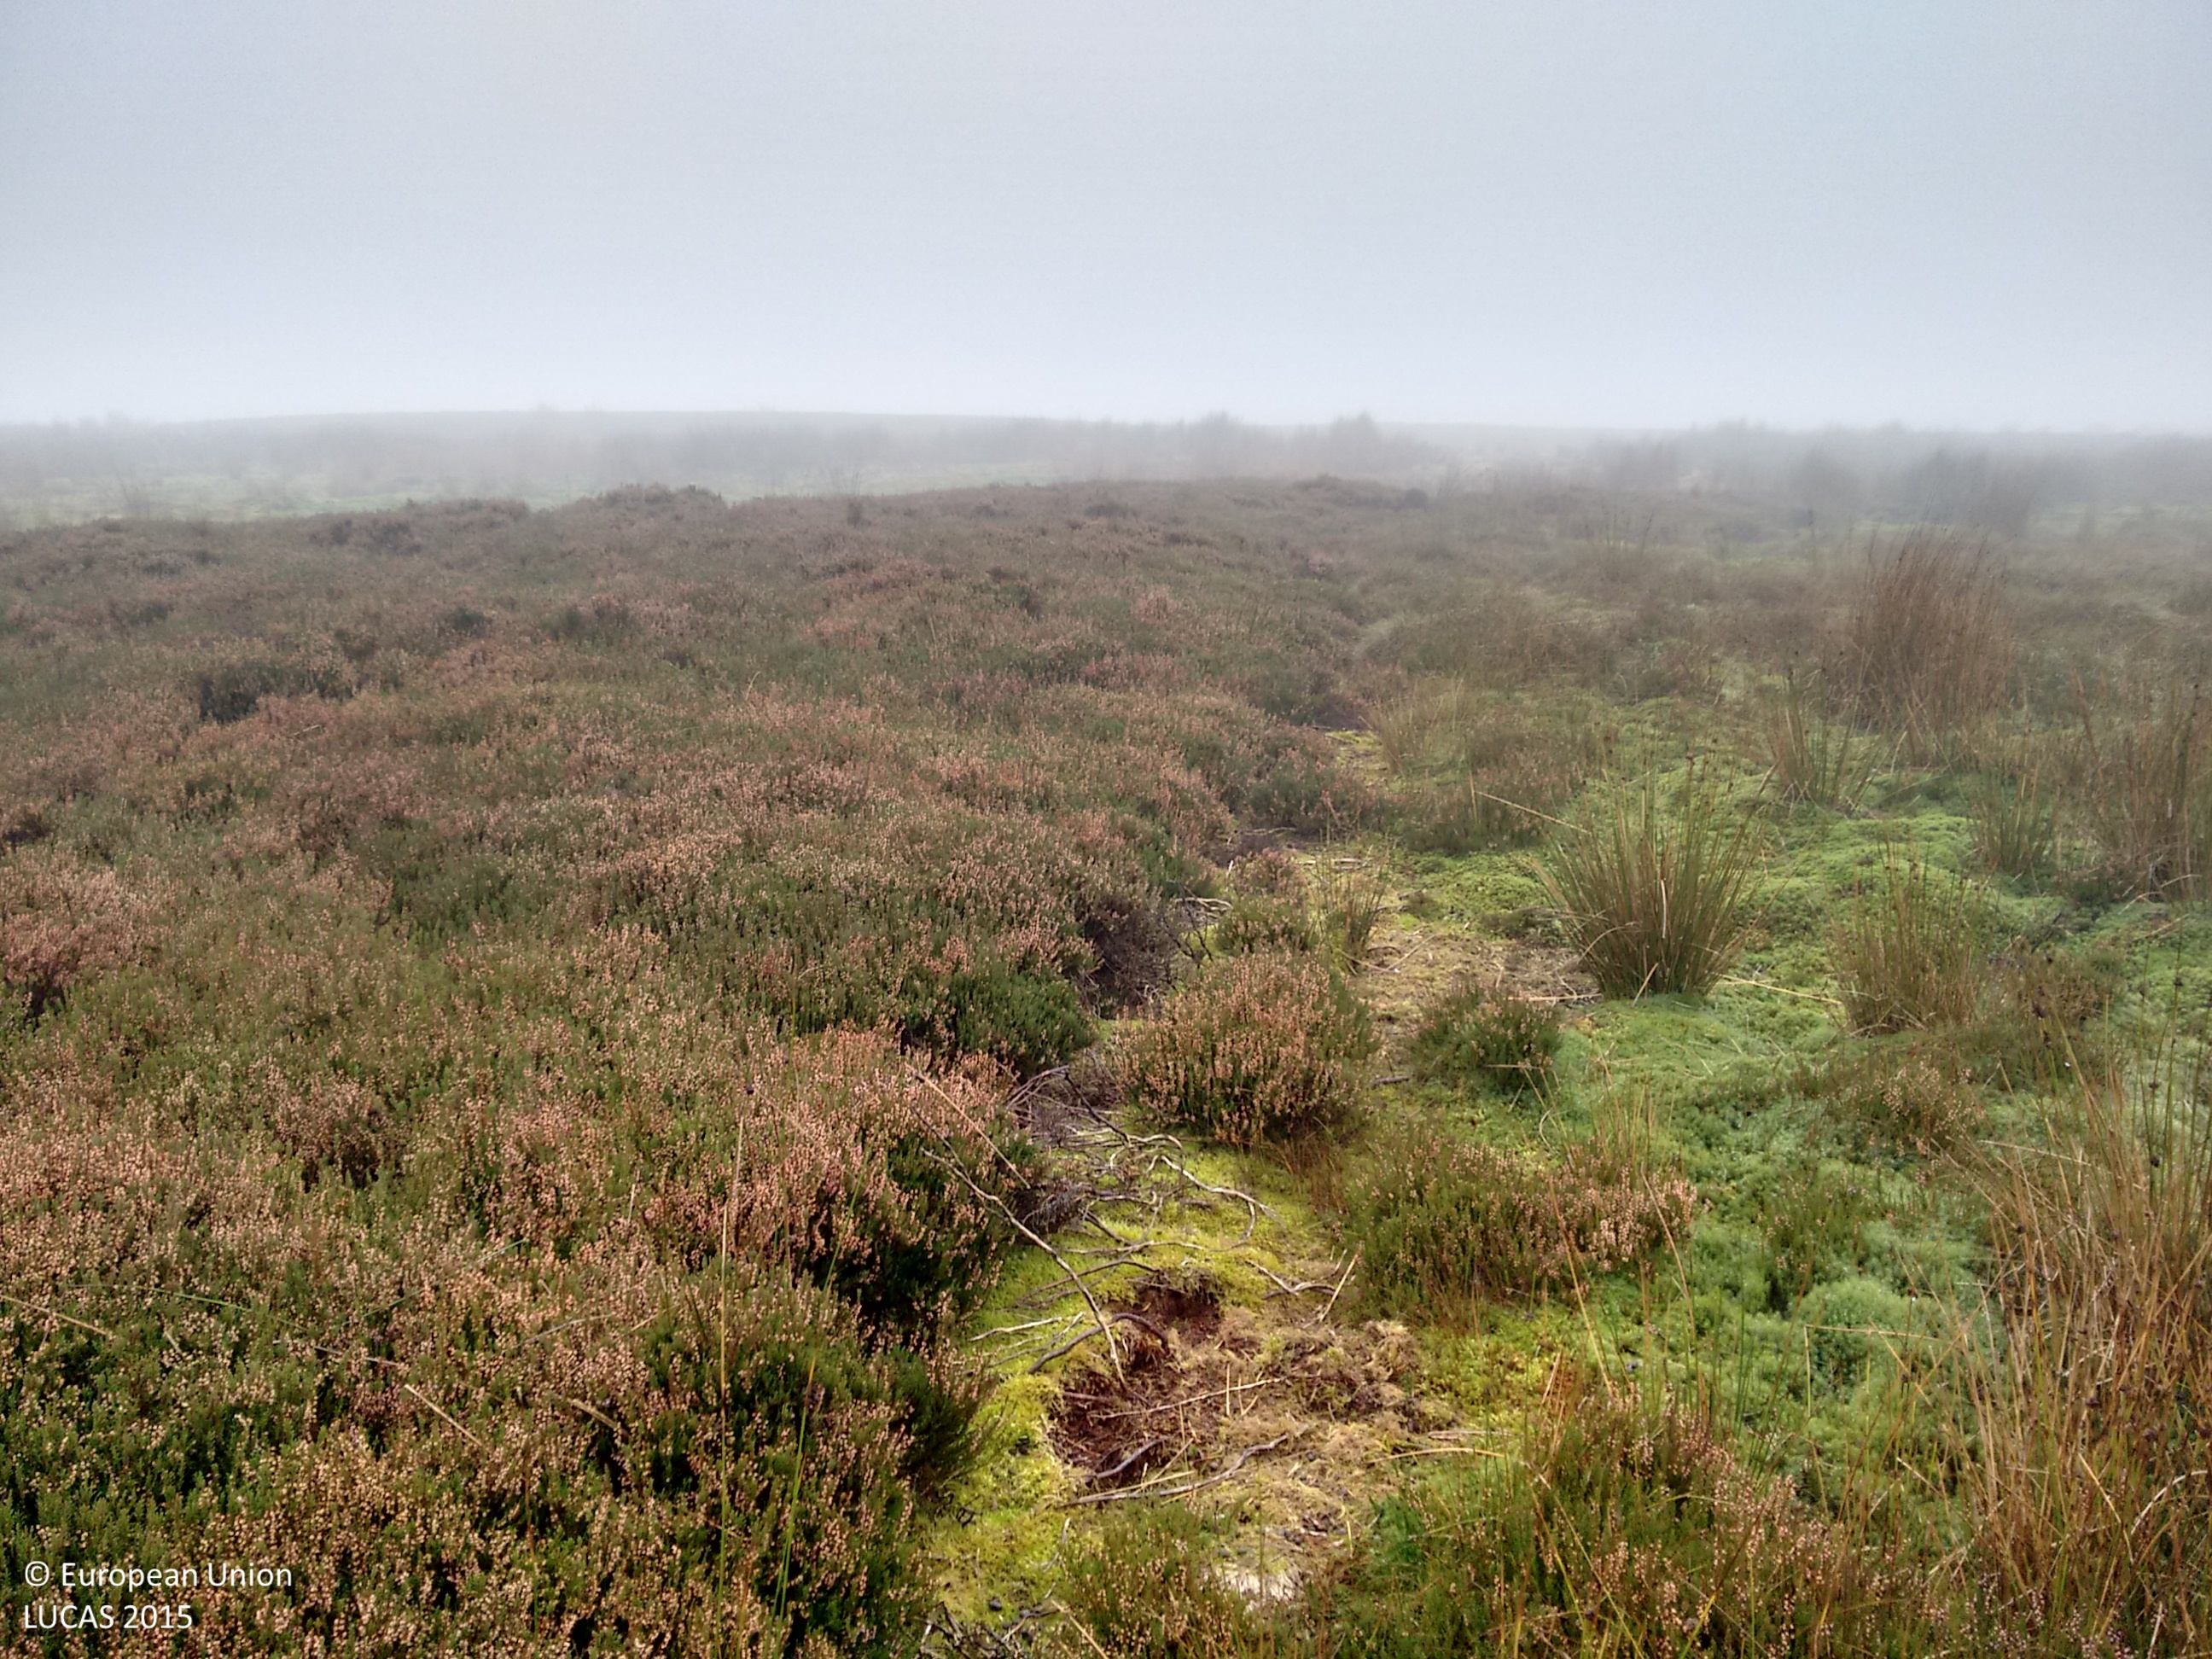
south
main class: Shrubland
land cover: Shrubland without tree cover
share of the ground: > 75 %
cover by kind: shrubs 80 %, herbaceous plants 20 %
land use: Semi-natural and natural areas not in use
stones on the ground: < 10 %
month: October
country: GB
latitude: 54.4654
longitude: -2.1071
